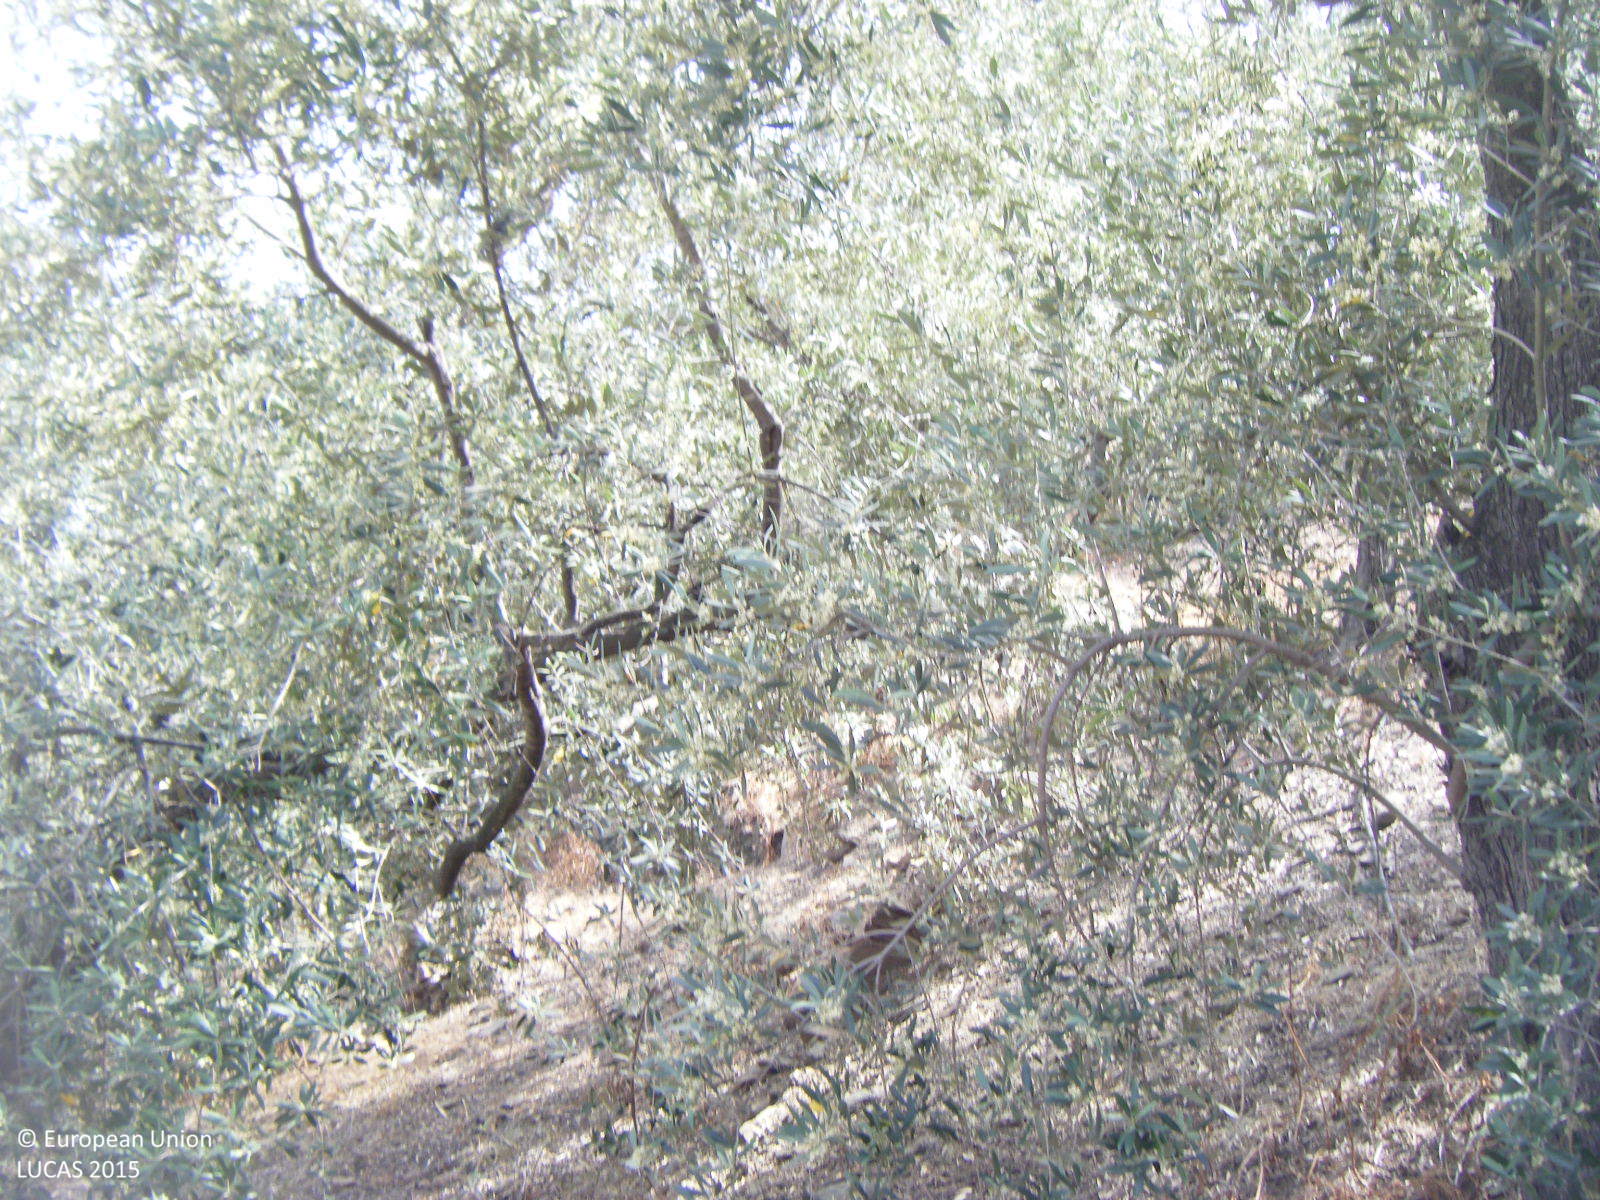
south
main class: Cropland
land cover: Olive groves
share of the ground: 25 - 50 %
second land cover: Other bare soil
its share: > 75 %
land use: Agriculture (excluding fallow land and kitchen gardens)
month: May
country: ES
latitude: 36.8150
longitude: -4.0108
